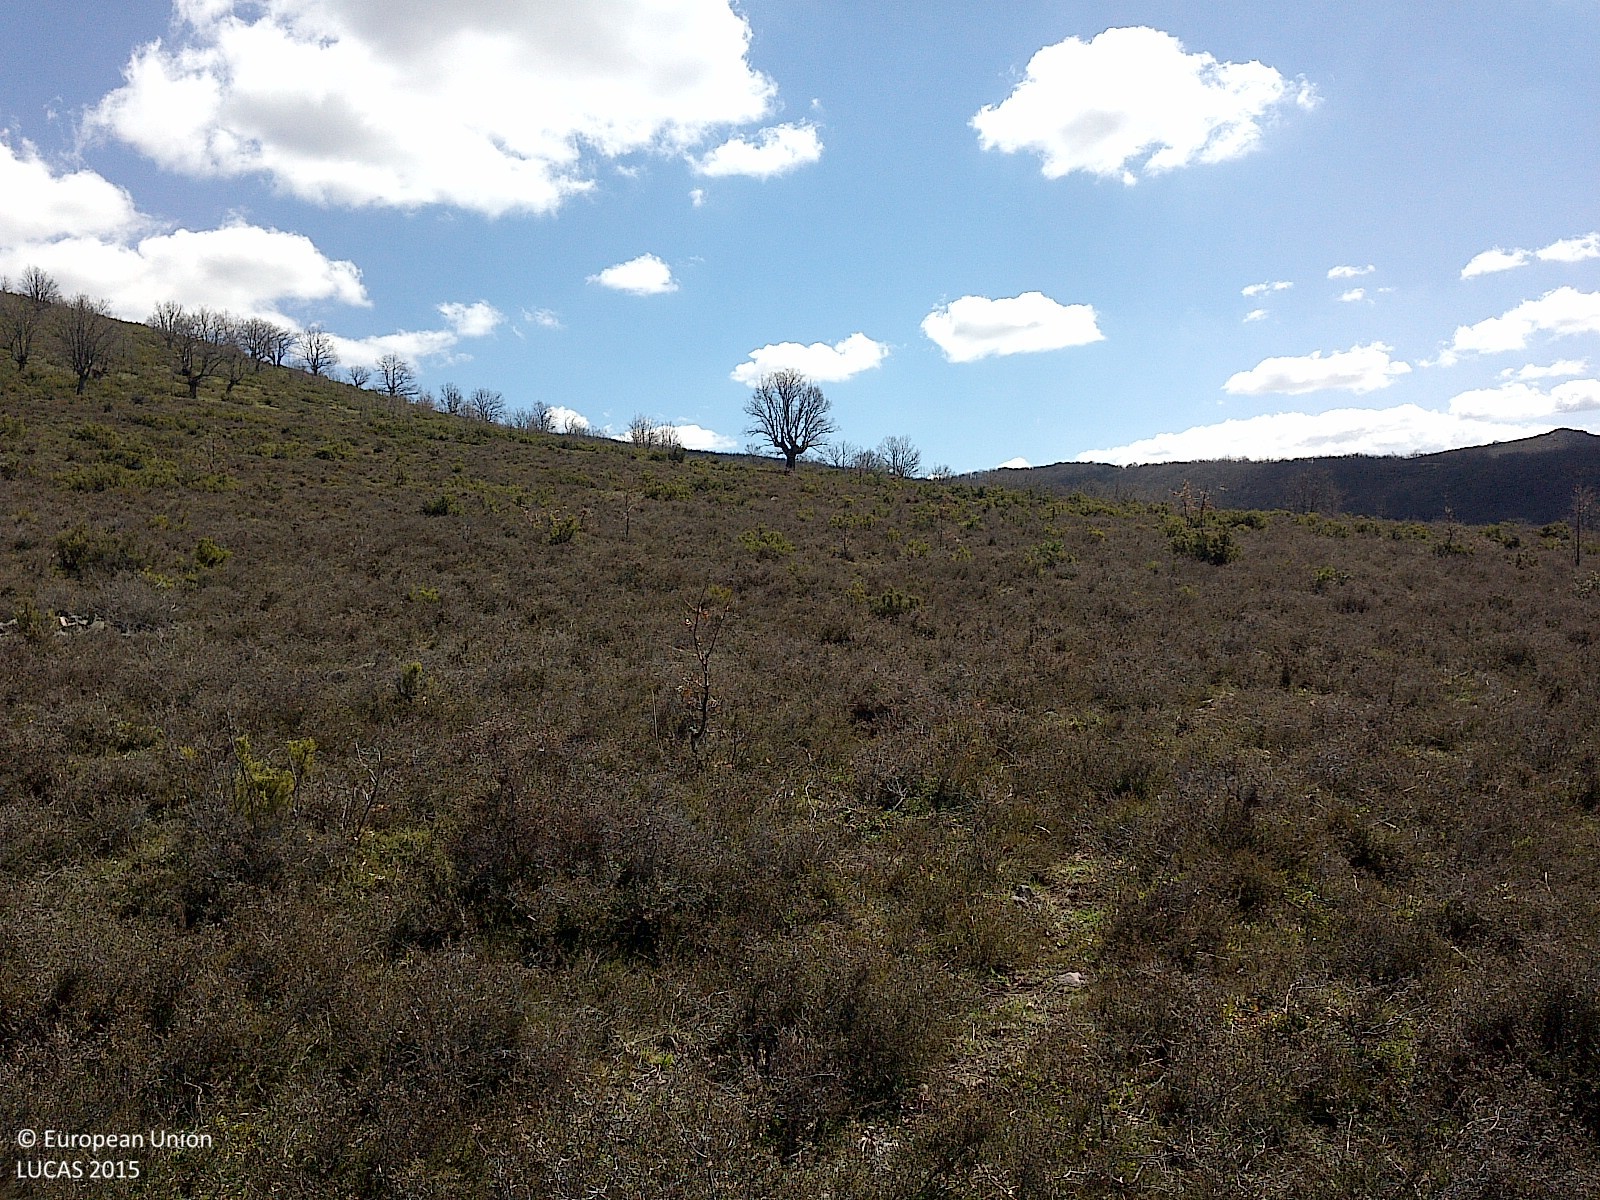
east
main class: Shrubland
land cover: Shrubland without tree cover
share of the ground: > 75 %
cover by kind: shrubs 95 %, herbaceous plants 5 %
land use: Agriculture (excluding fallow land and kitchen gardens)
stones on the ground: < 10 %
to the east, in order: Shrubland without tree cover; Shrubland with sparse tree cover
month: April
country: ES
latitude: 42.1558
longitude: -3.3048
